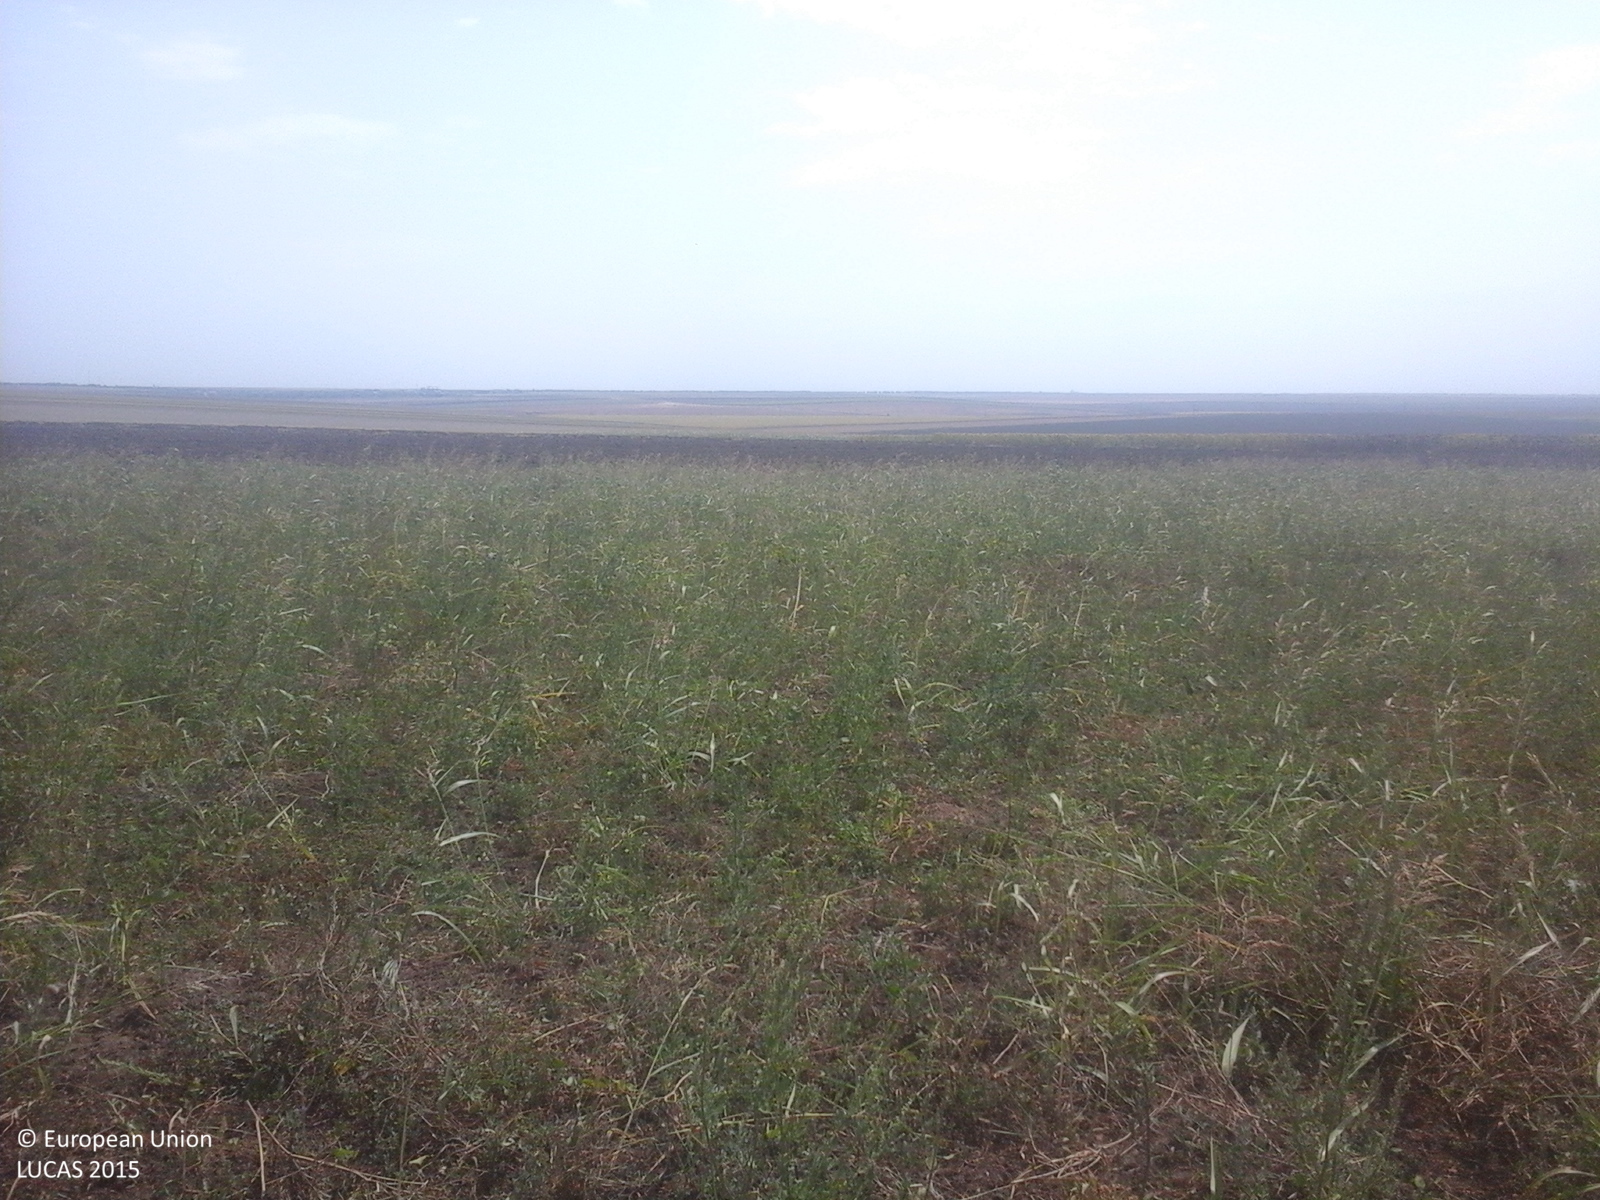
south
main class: Grassland
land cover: Spontaneously vegetated surfaces
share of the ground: < 10 %
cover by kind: herbaceous plants 100 %
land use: Fallow land
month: August
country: RO
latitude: 43.9404
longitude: 28.3127
